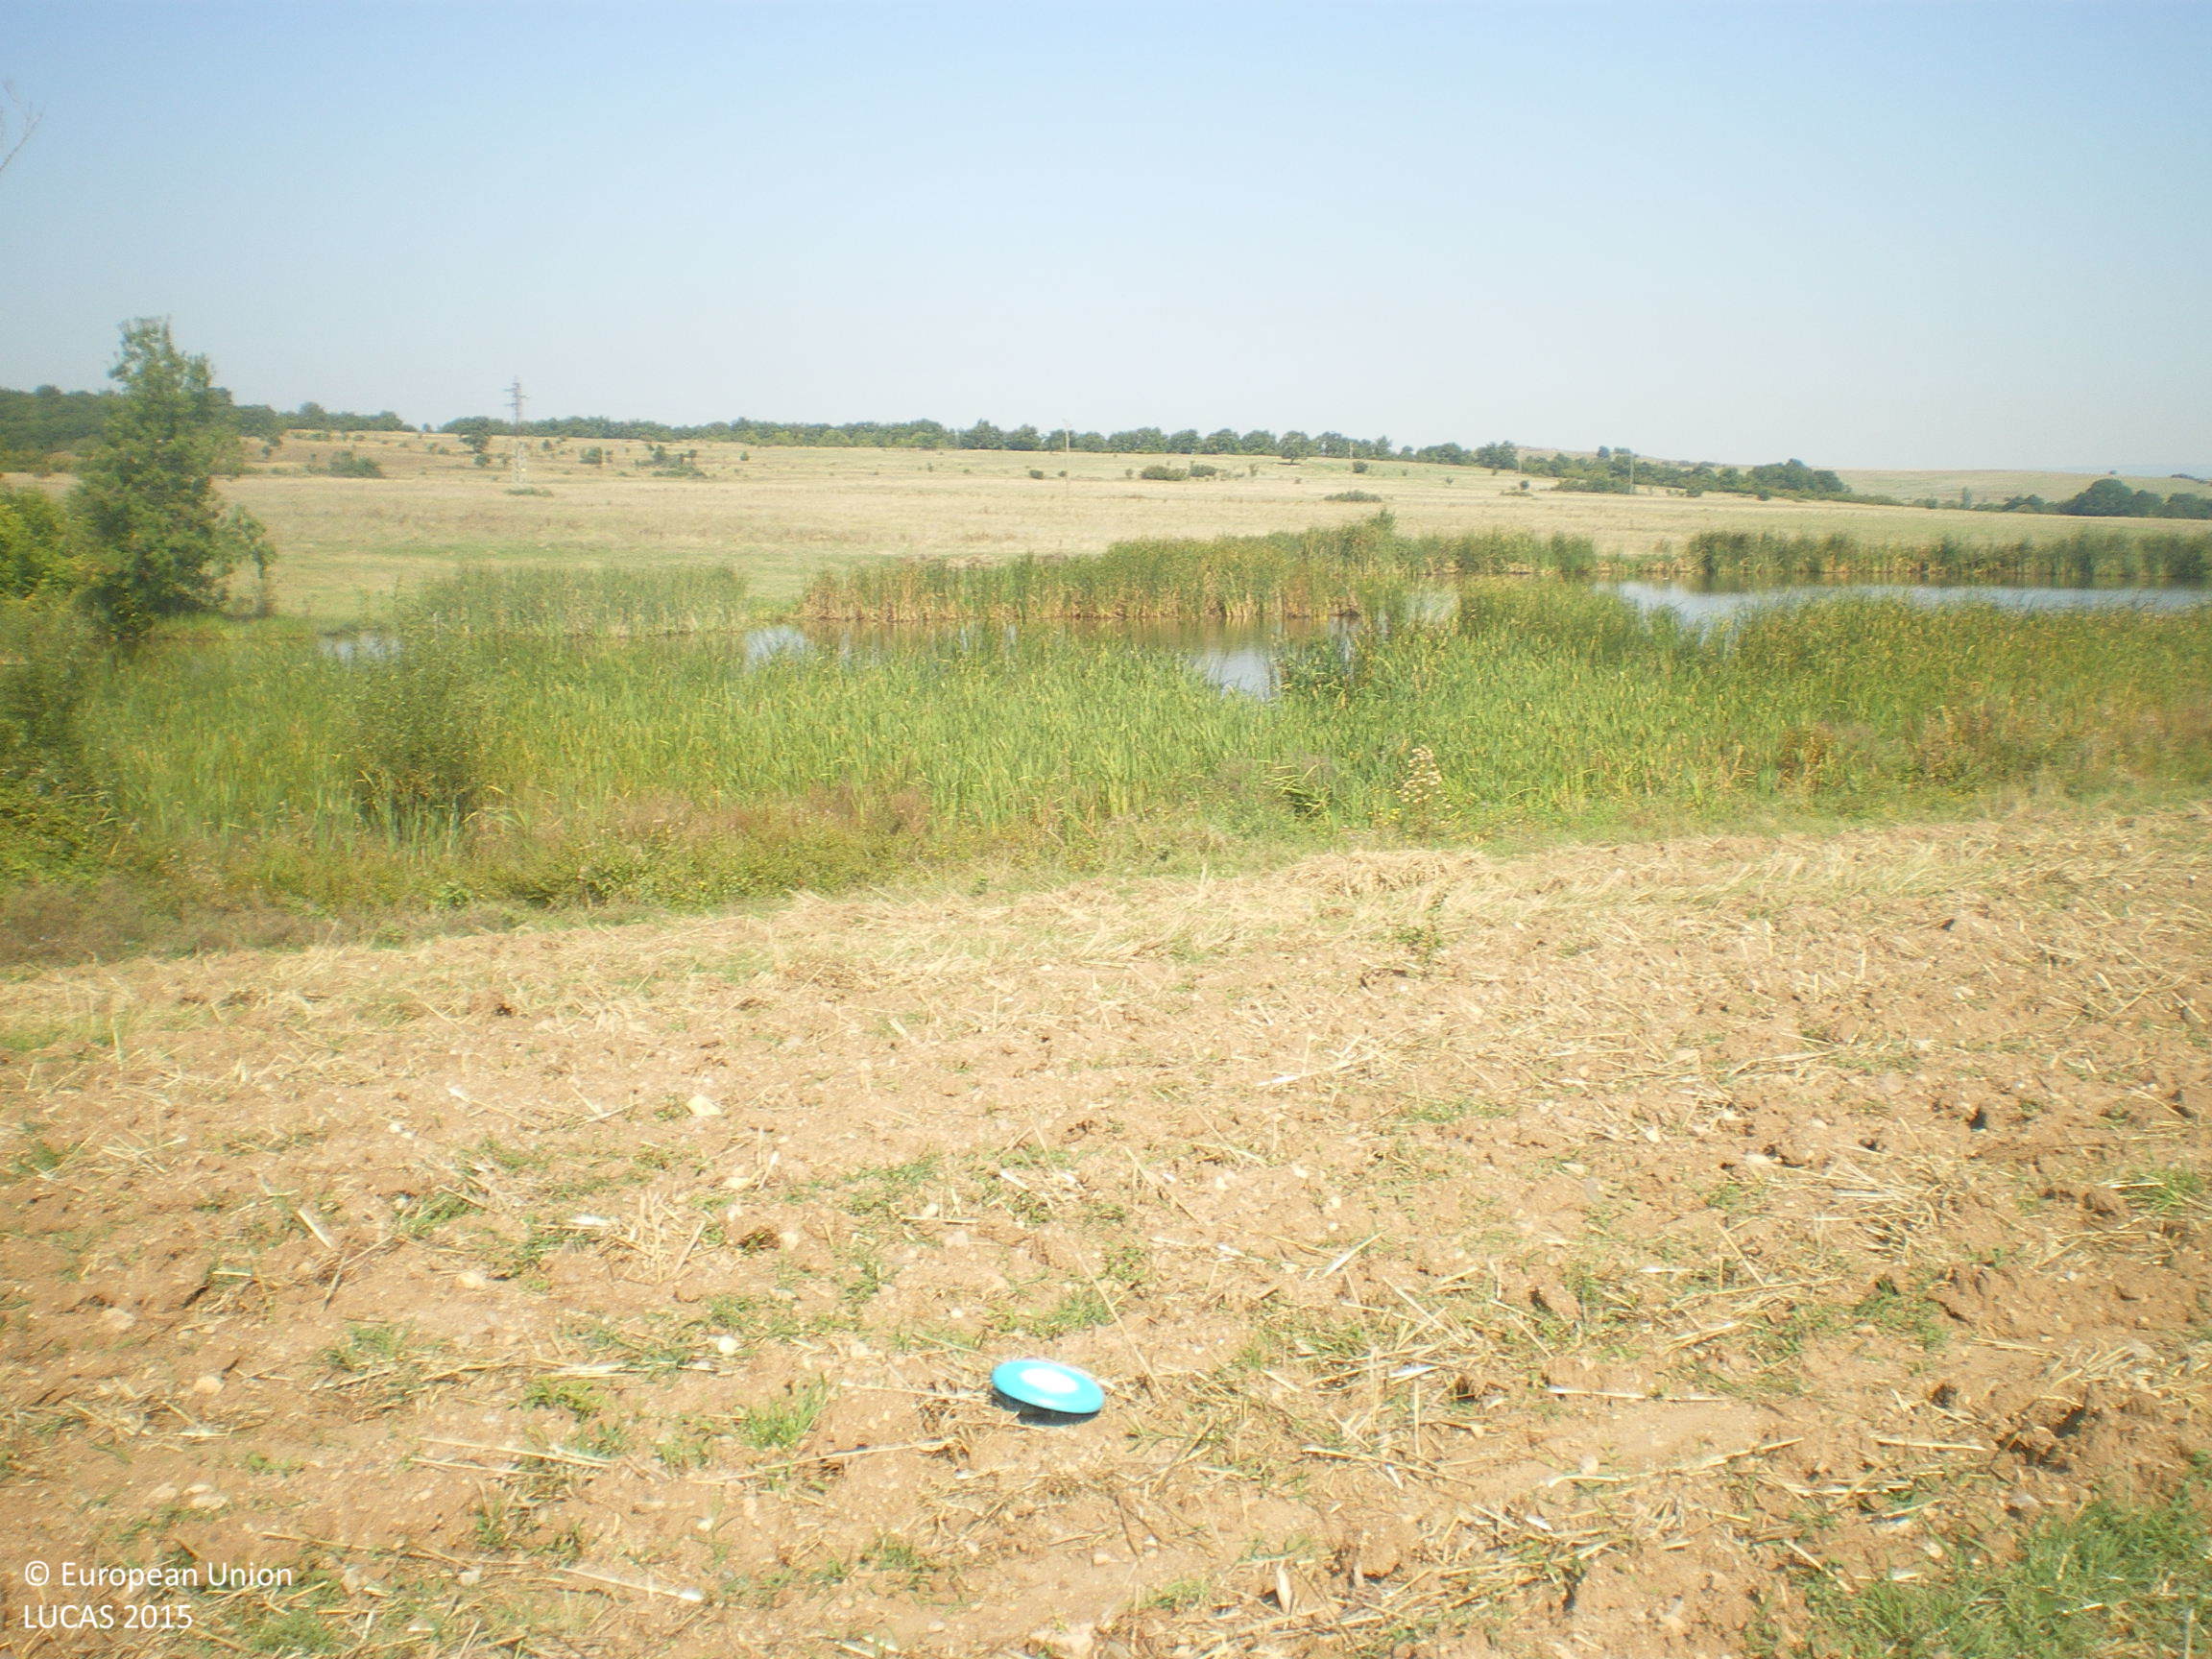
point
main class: Cropland
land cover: Common wheat
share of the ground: < 10 %
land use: Agriculture (excluding fallow land and kitchen gardens)
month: September
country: BG
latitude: 41.7924
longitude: 26.0168
